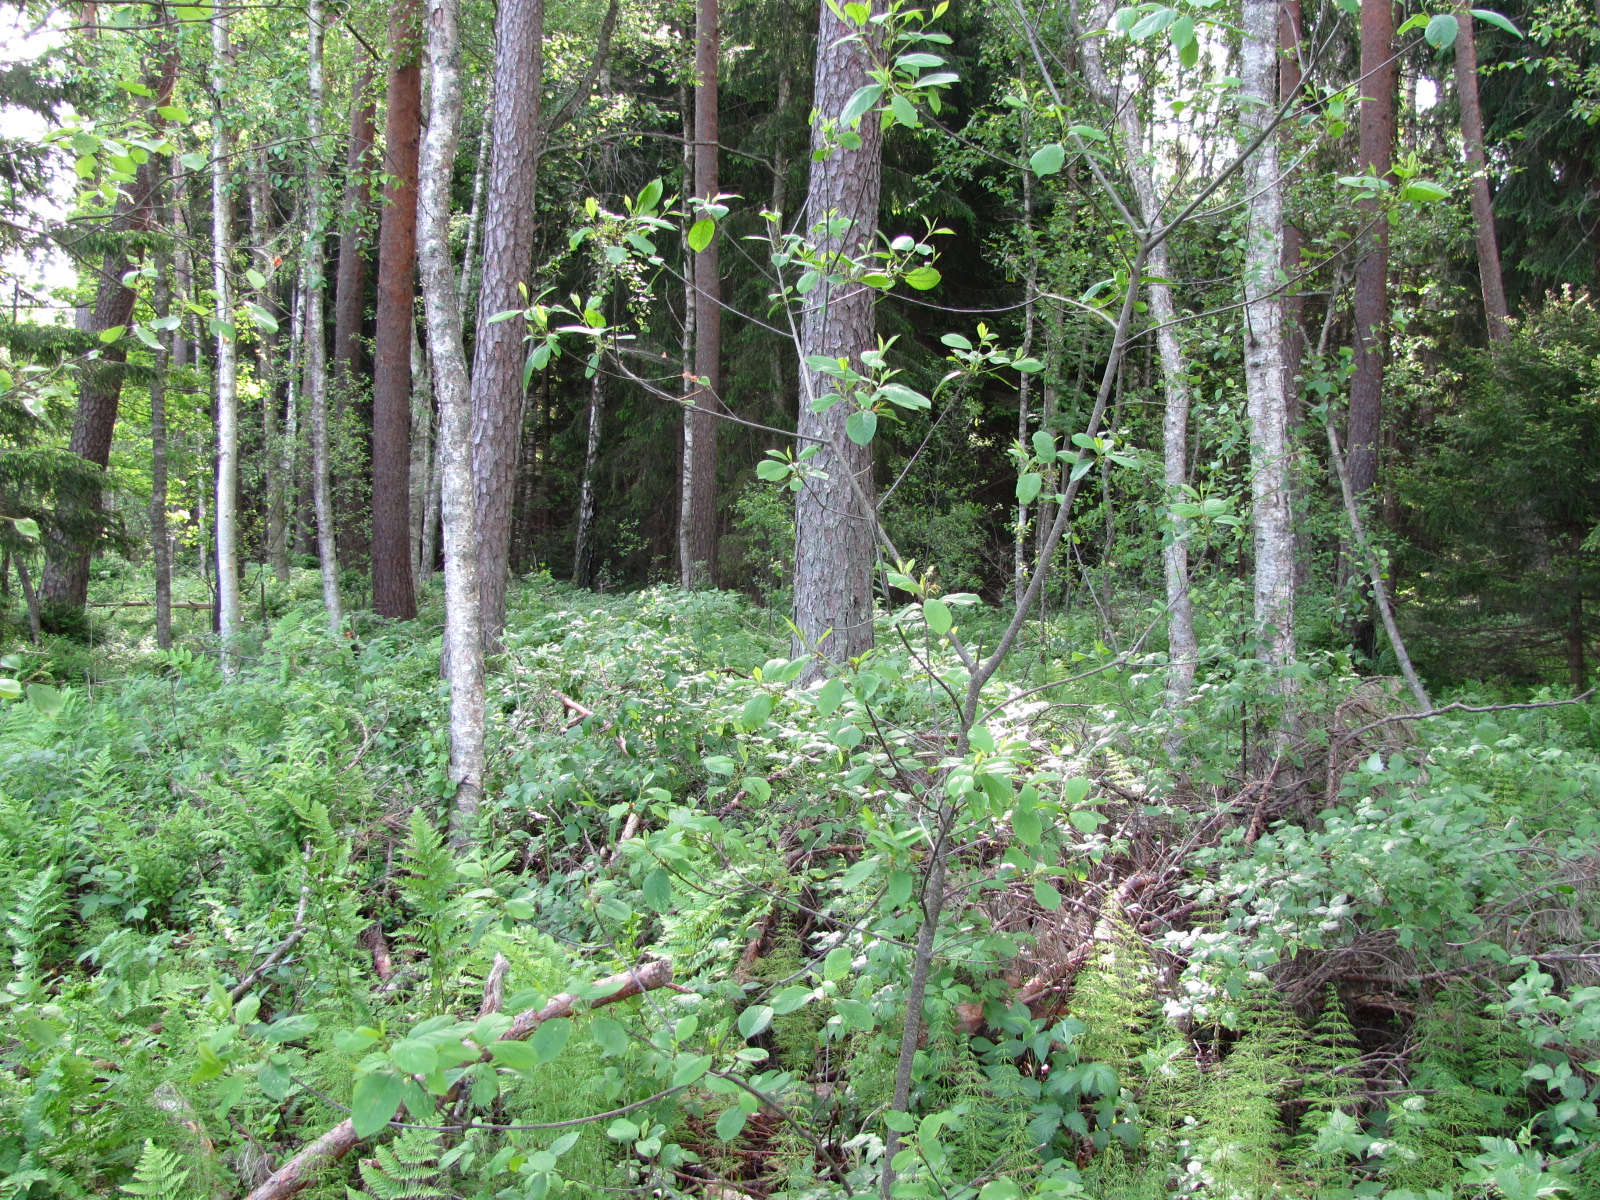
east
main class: Woodland
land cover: Other mixed woodland
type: hemiboreal forest and nemoral coniferous forest and mixed broadleaved-coniferous forest
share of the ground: > 75 %
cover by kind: broadleaved forest trees 45 %, coniferous forest trees 40 %, herbaceous plants 15 %
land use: Forestry
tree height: > 5 m
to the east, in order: Other mixed woodland; Shruby margins; Tracks; Shruby margins; Ditches and canals; Shruby margins; Other coniferous woodland; Other mixed woodland
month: June
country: LV
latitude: 56.7357
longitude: 23.9618
